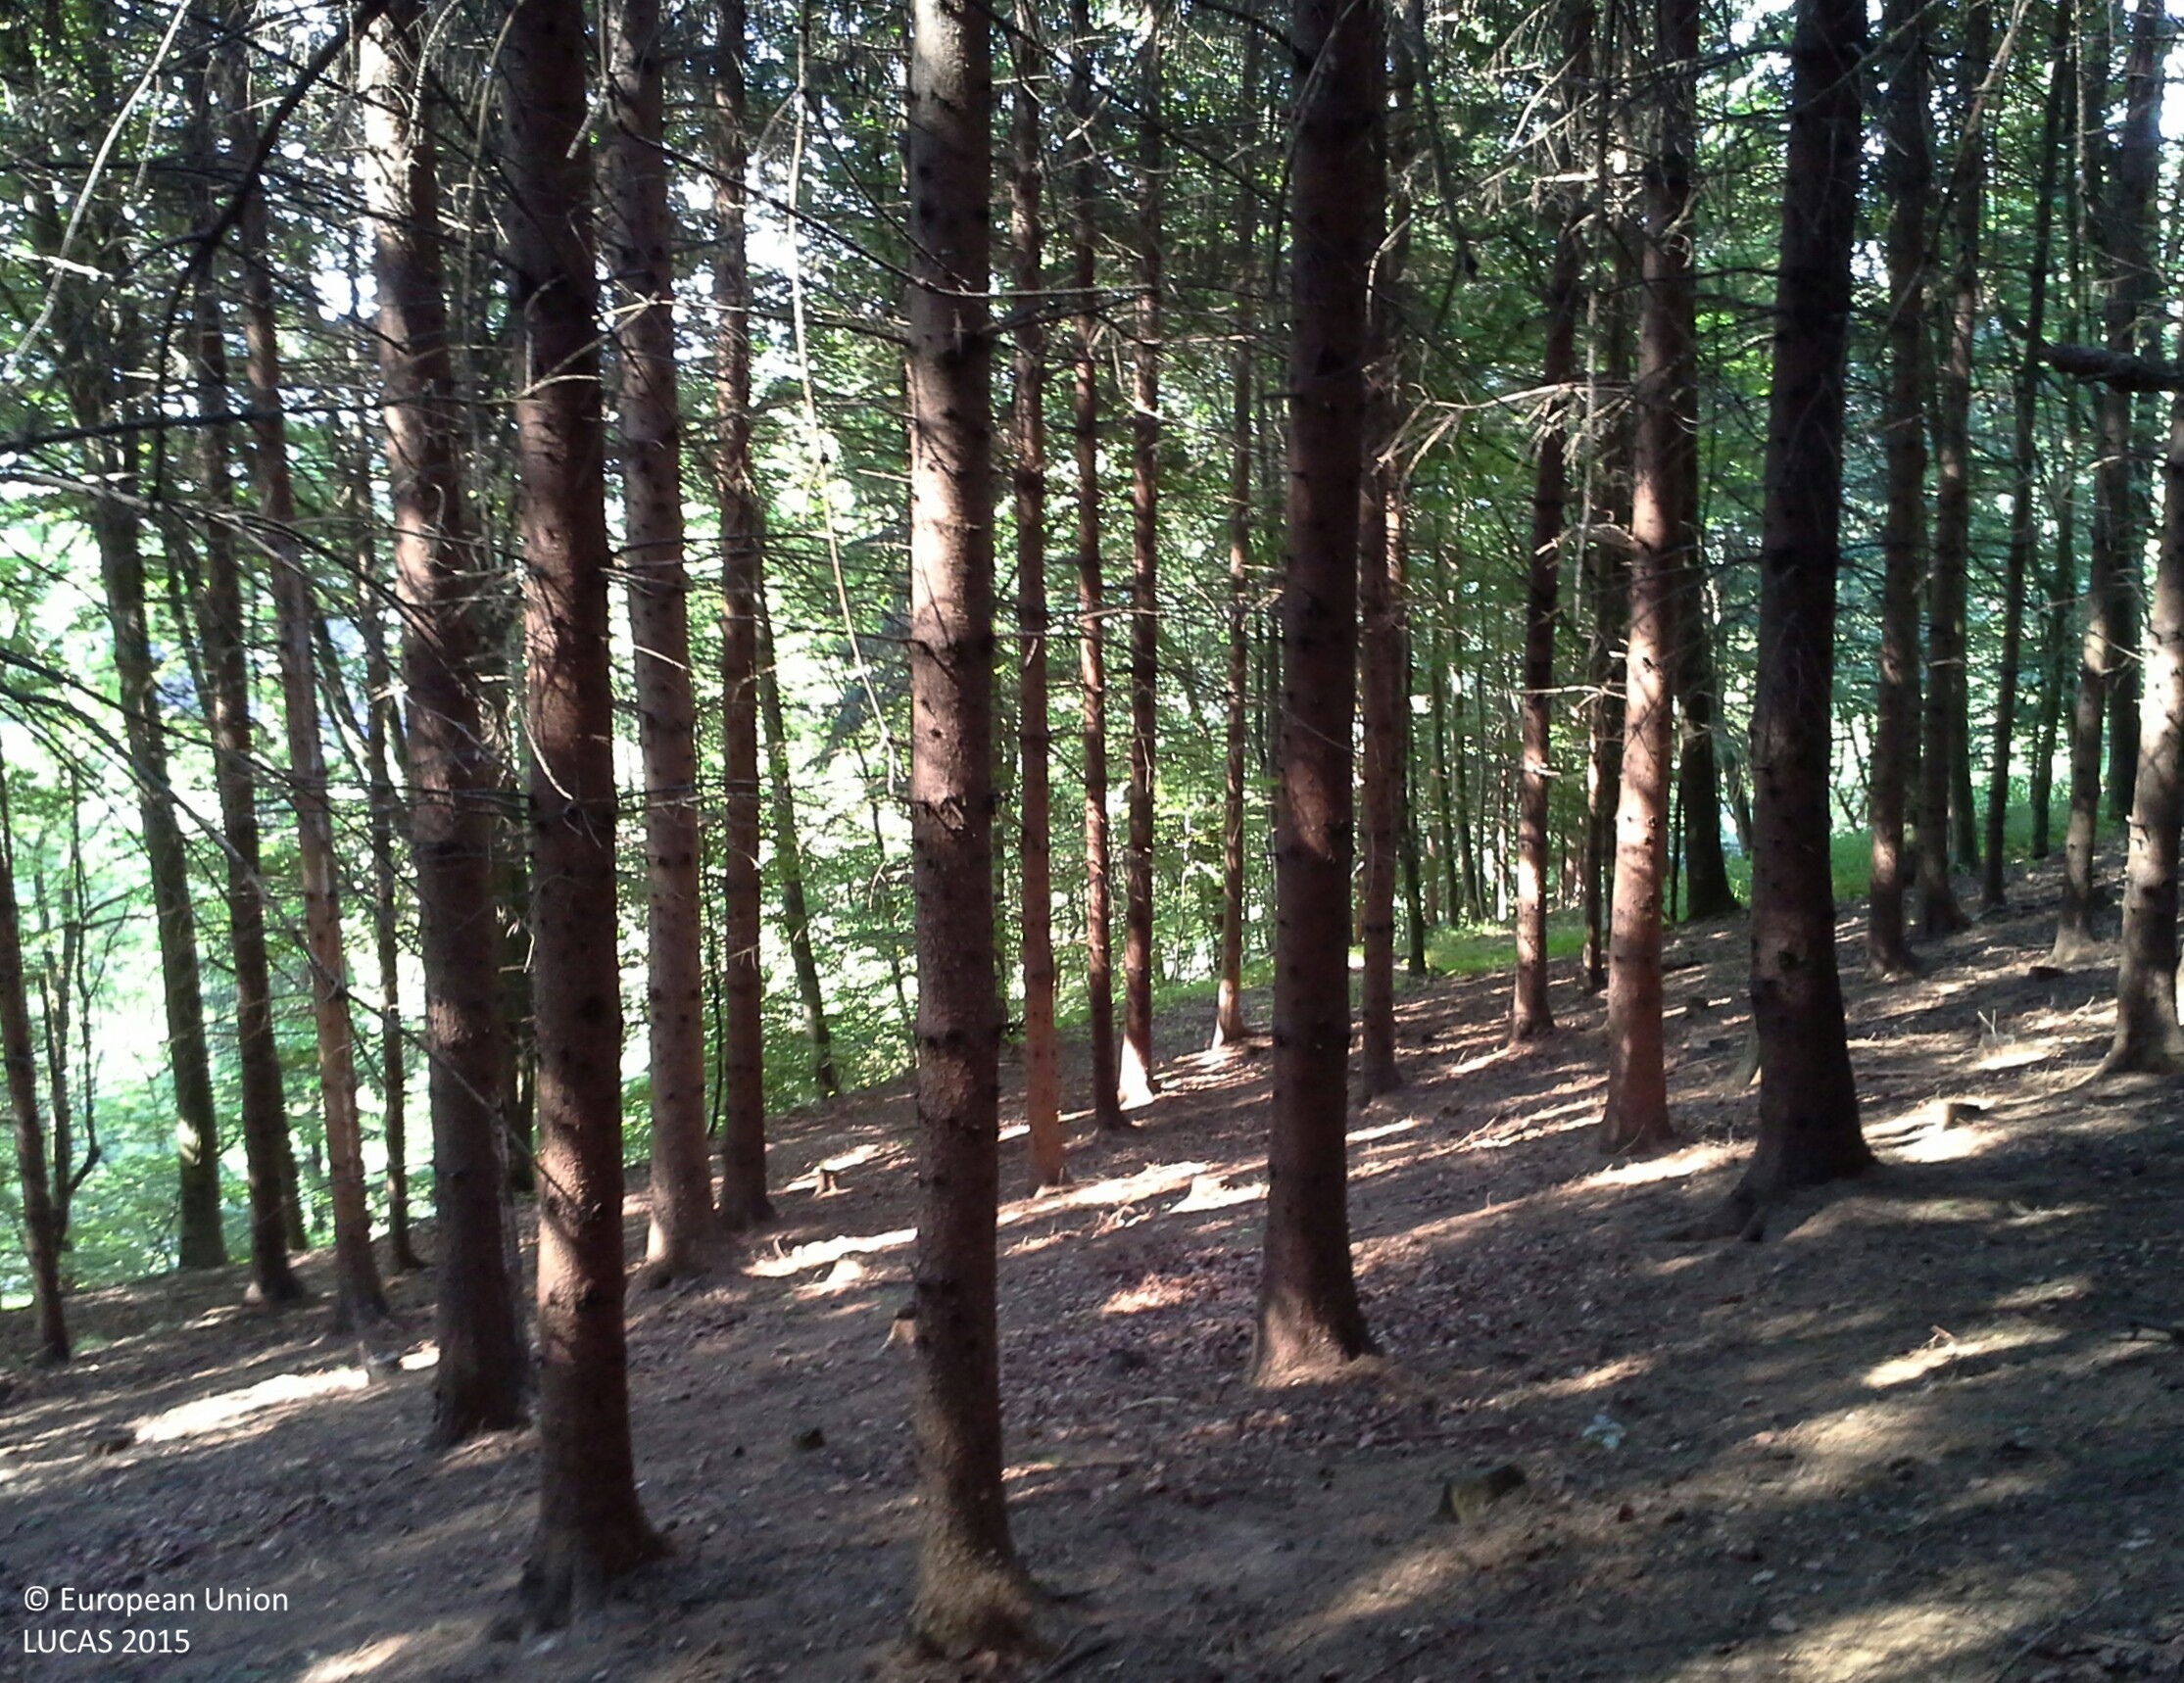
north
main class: Woodland
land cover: Spruce dominated coniferous woodland
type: hemiboreal forest and nemoral coniferous forest and mixed broadleaved-coniferous forest
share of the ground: > 75 %
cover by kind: coniferous forest trees 100 %
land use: Forestry
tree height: > 5 m
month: July
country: AT
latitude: 48.1109
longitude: 14.9840
